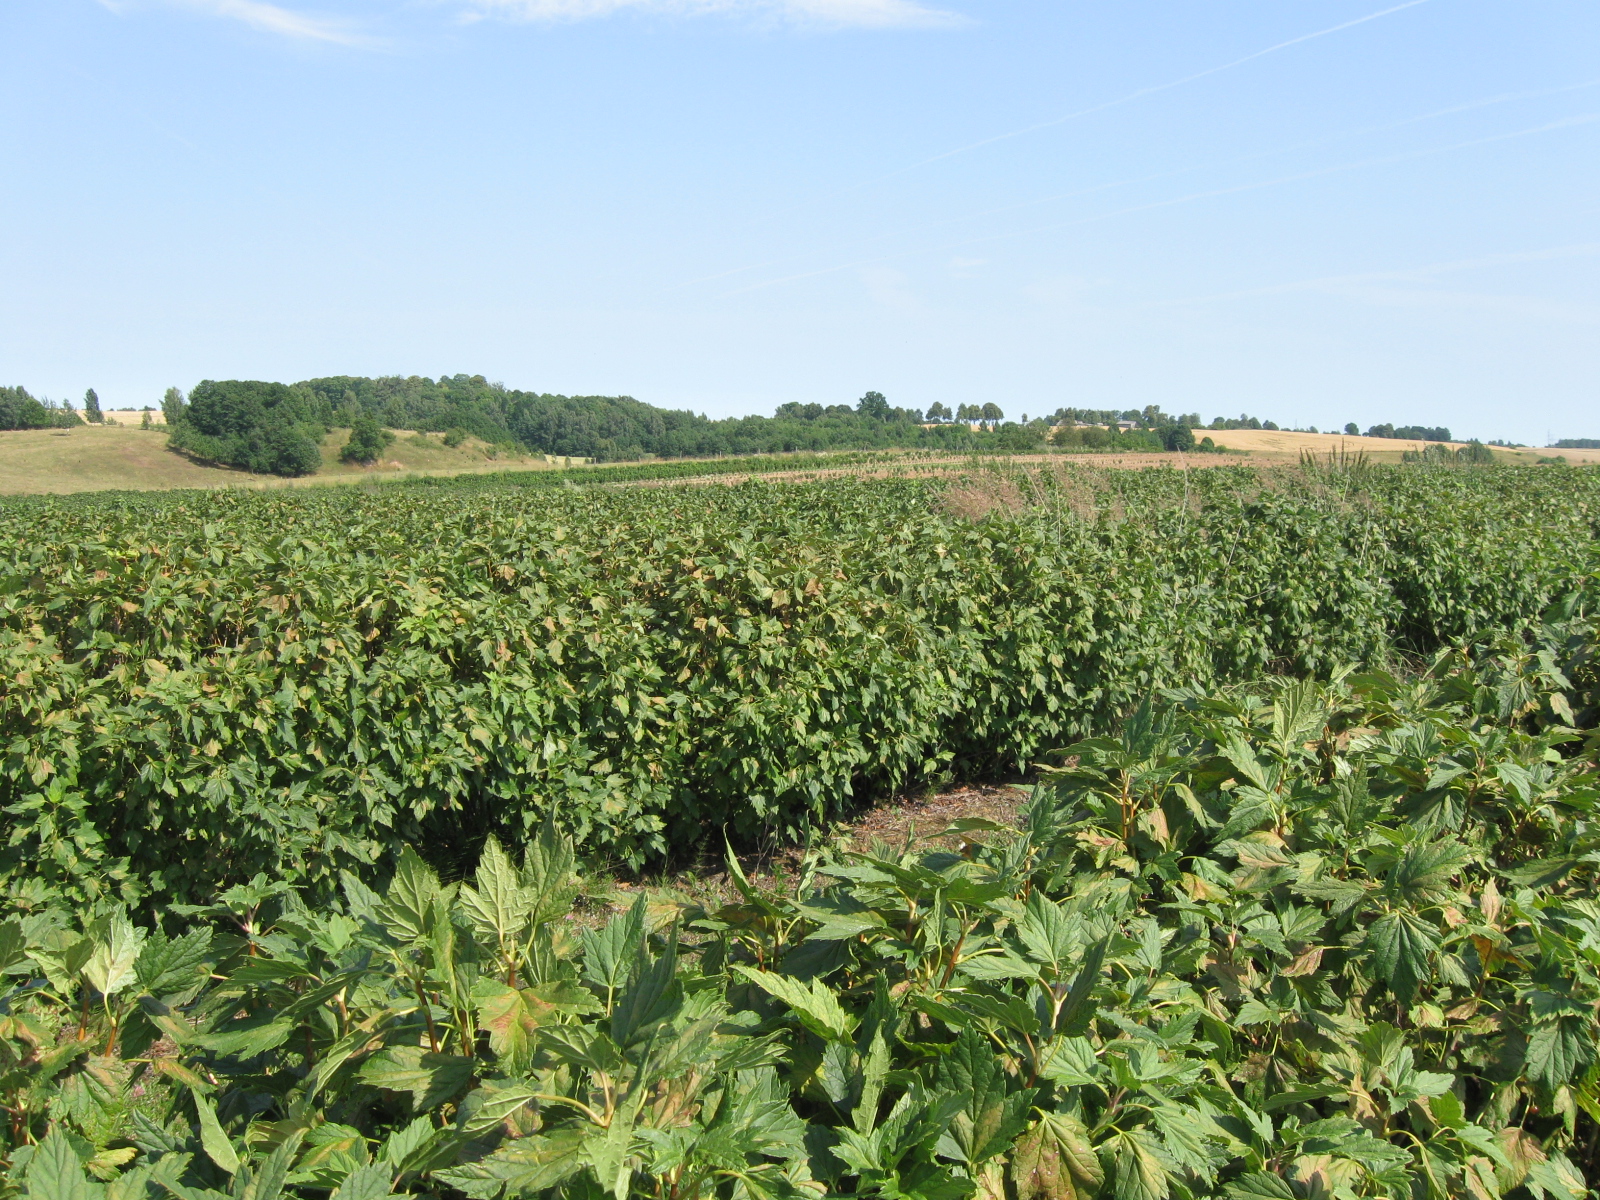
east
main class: Cropland
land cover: Other fruit trees and berries
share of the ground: 50 - 75 %
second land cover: Spontaneously vegetated surfaces
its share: 50 - 75 %
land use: Agriculture (excluding fallow land and kitchen gardens)
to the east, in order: Other fruit trees and berries; Spontaneously vegetated surfaces; Fences; Grassland without tree/shrub cover
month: July
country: LT
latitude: 54.6937
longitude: 23.9136
